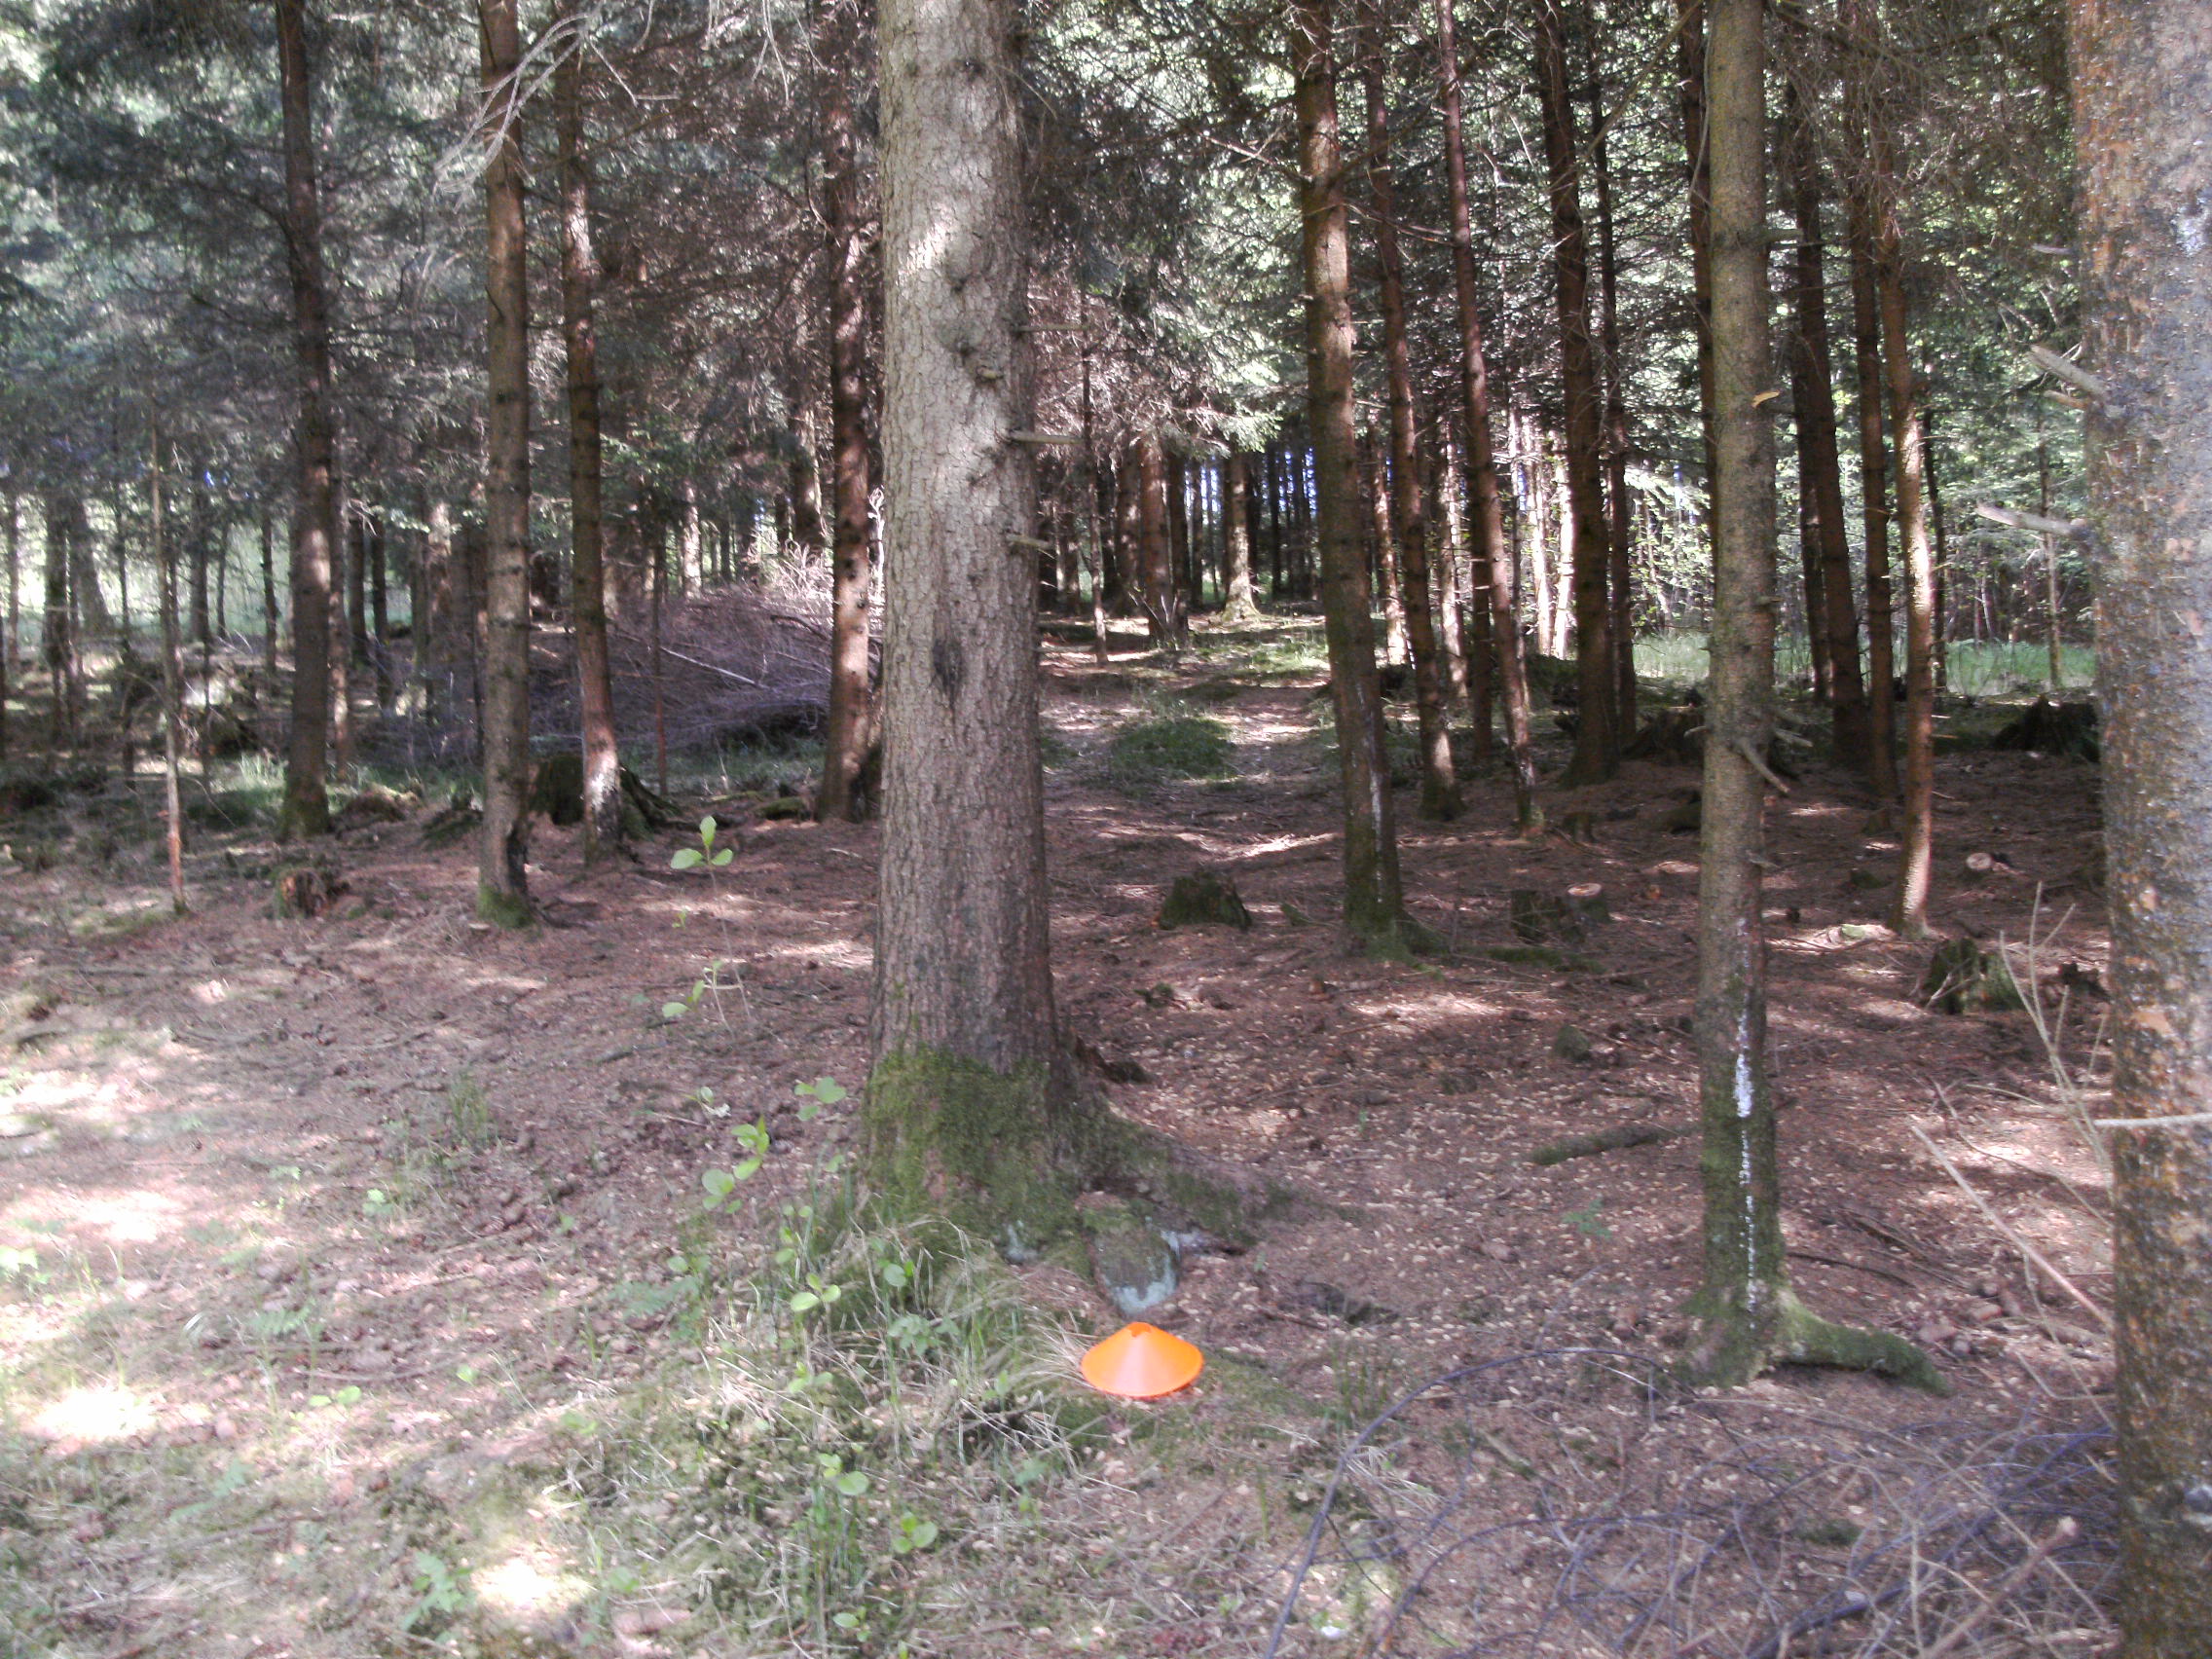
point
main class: Woodland
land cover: Spruce dominated coniferous woodland
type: hemiboreal forest and nemoral coniferous forest and mixed broadleaved-coniferous forest
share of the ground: > 75 %
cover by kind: coniferous forest trees 100 %
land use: Forestry
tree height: > 5 m
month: May
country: AT
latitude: 48.4364
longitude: 13.5544
